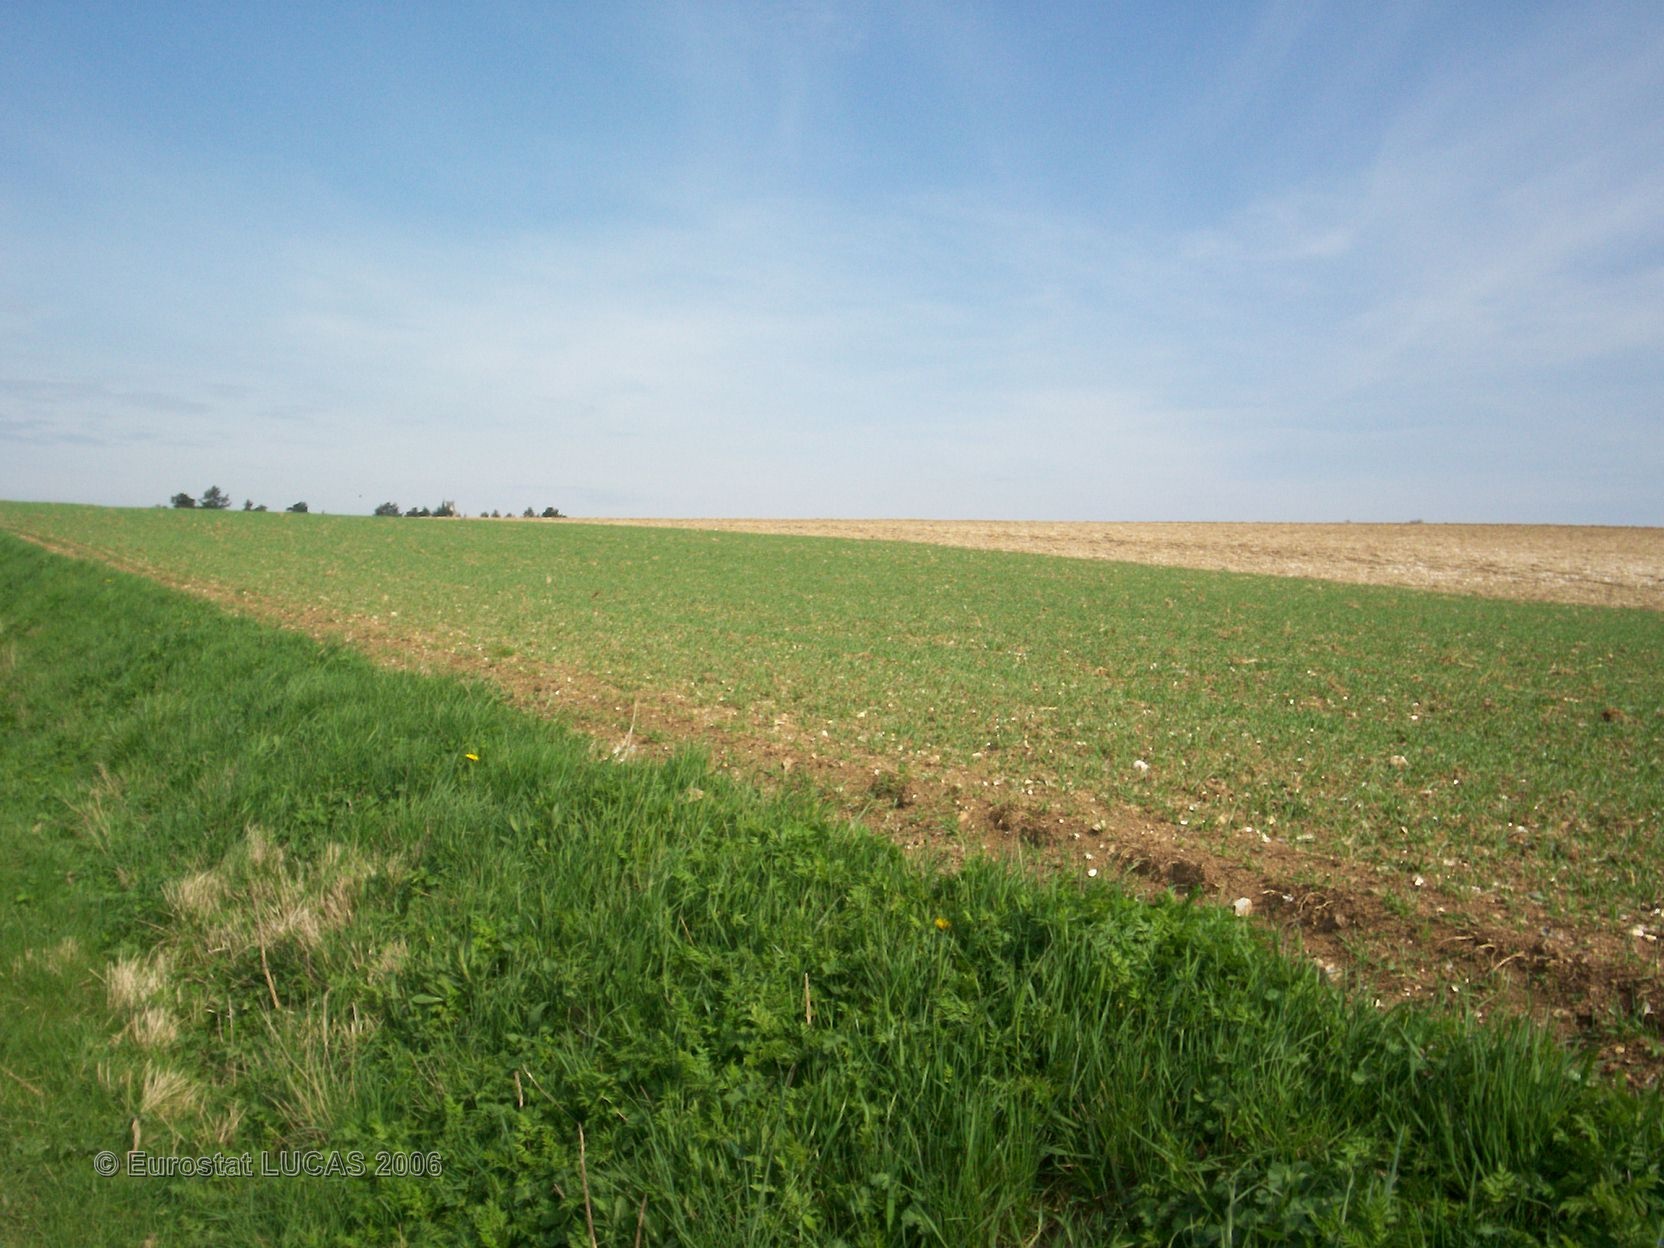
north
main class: Cropland
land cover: Common wheat
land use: Agriculture (excluding fallow land and kitchen gardens)
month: April
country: FR
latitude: 50.0574
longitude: 2.6834
